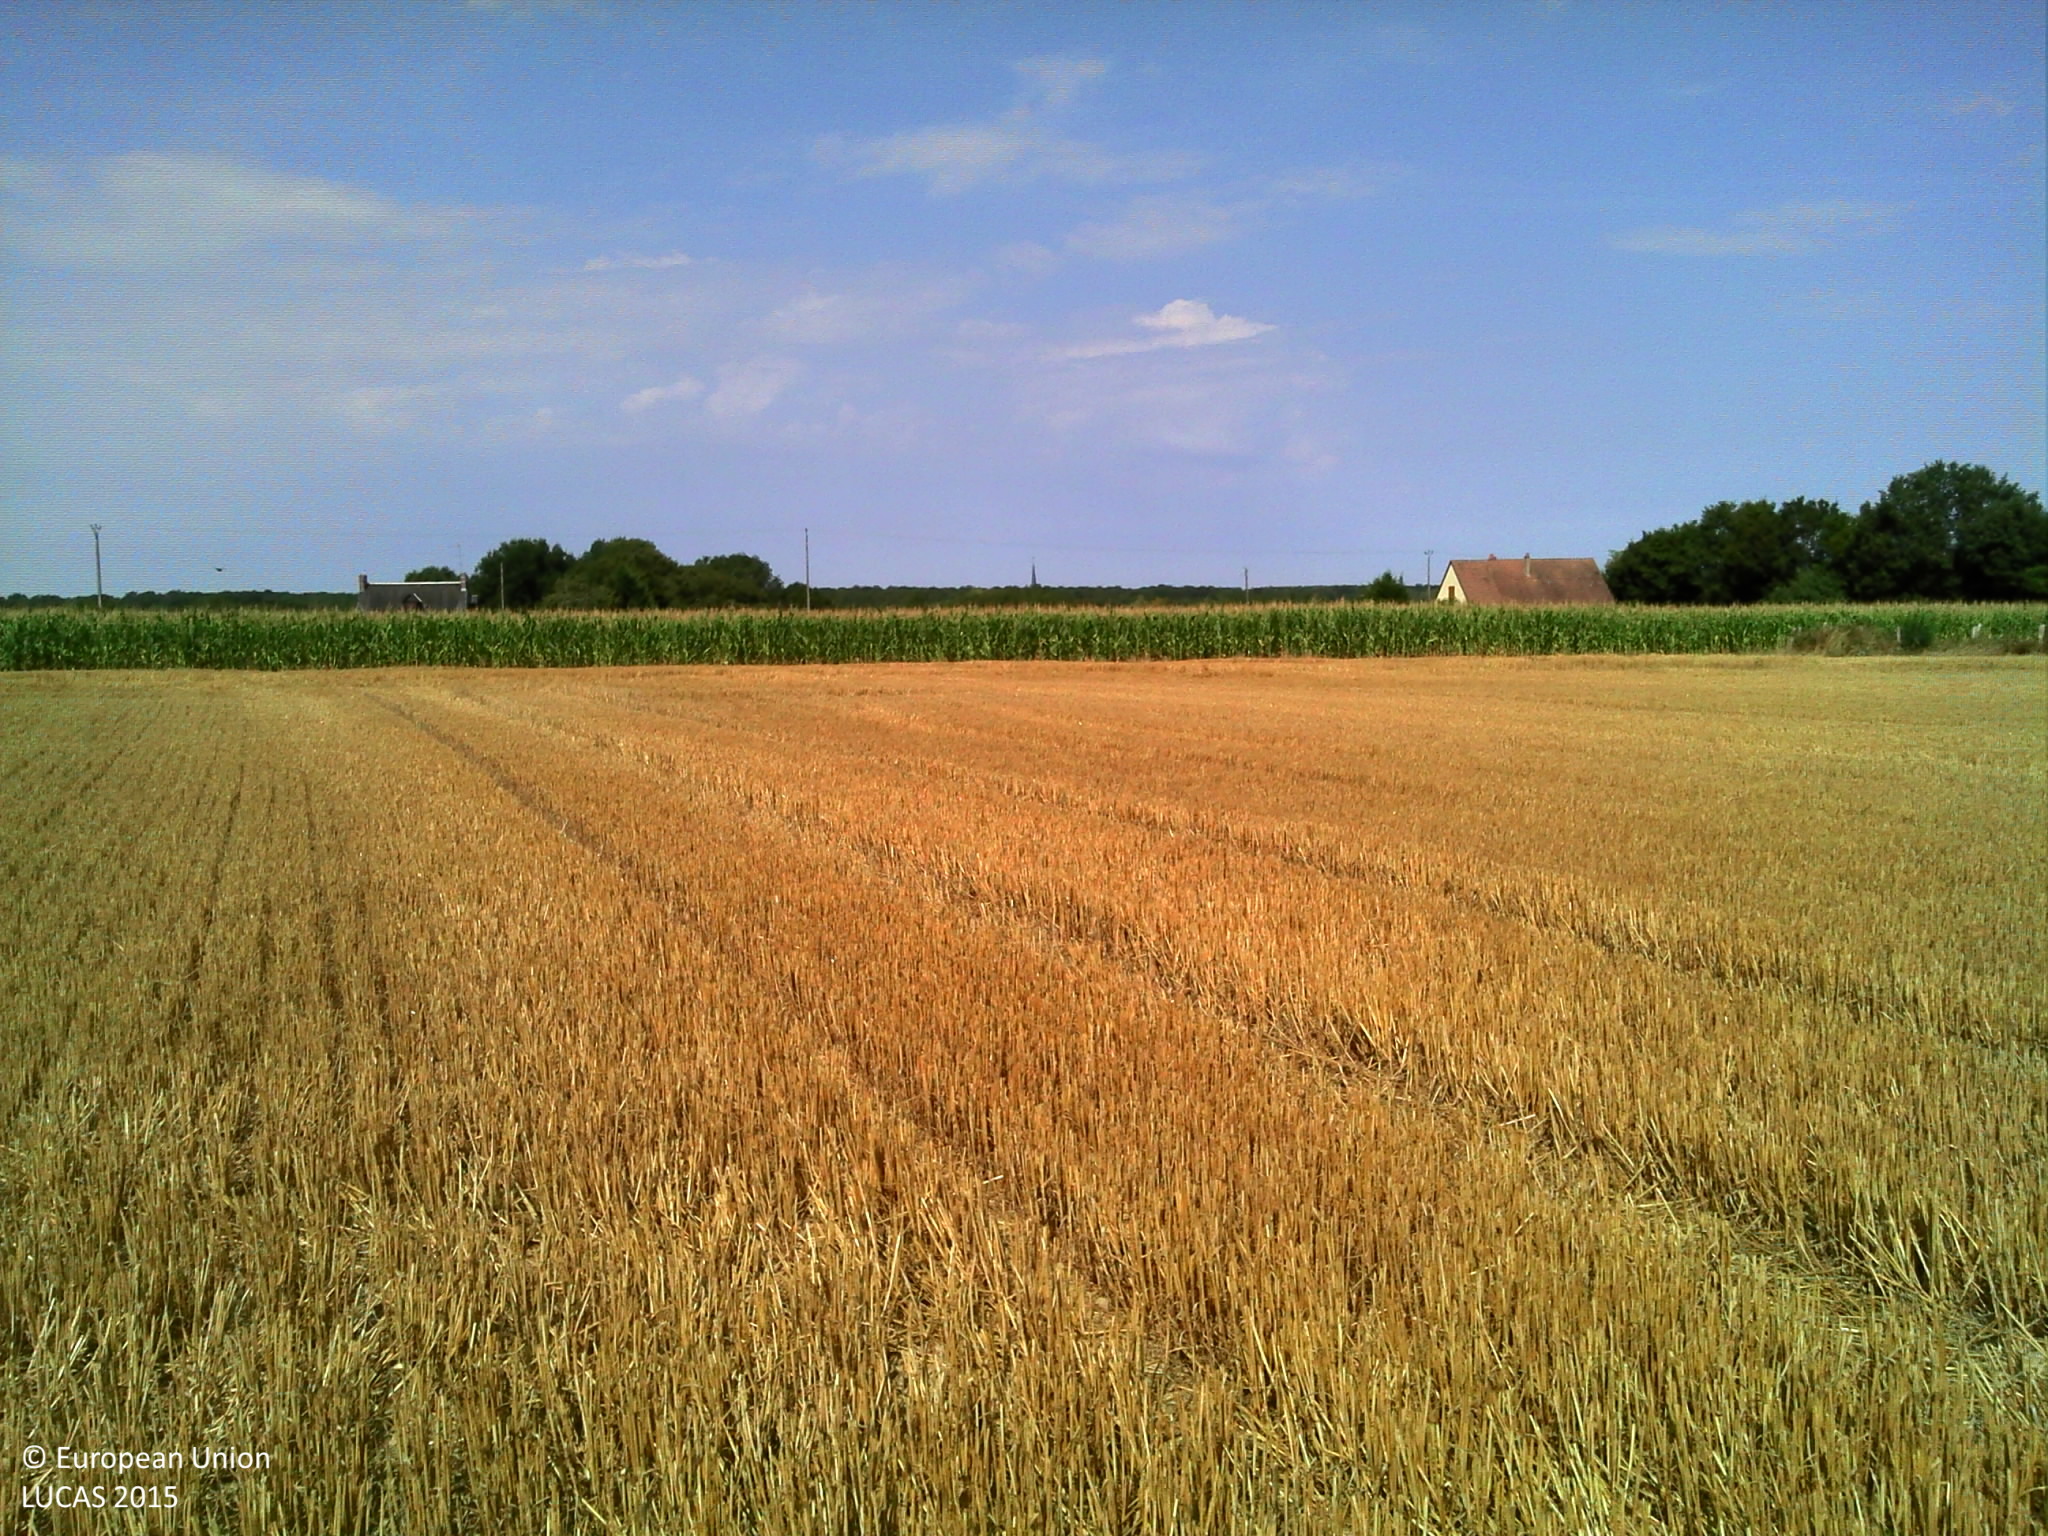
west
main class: Cropland
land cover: Common wheat
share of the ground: > 75 %
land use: Agriculture (excluding fallow land and kitchen gardens)
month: August
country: FR
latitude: 47.7005
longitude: 3.1047
